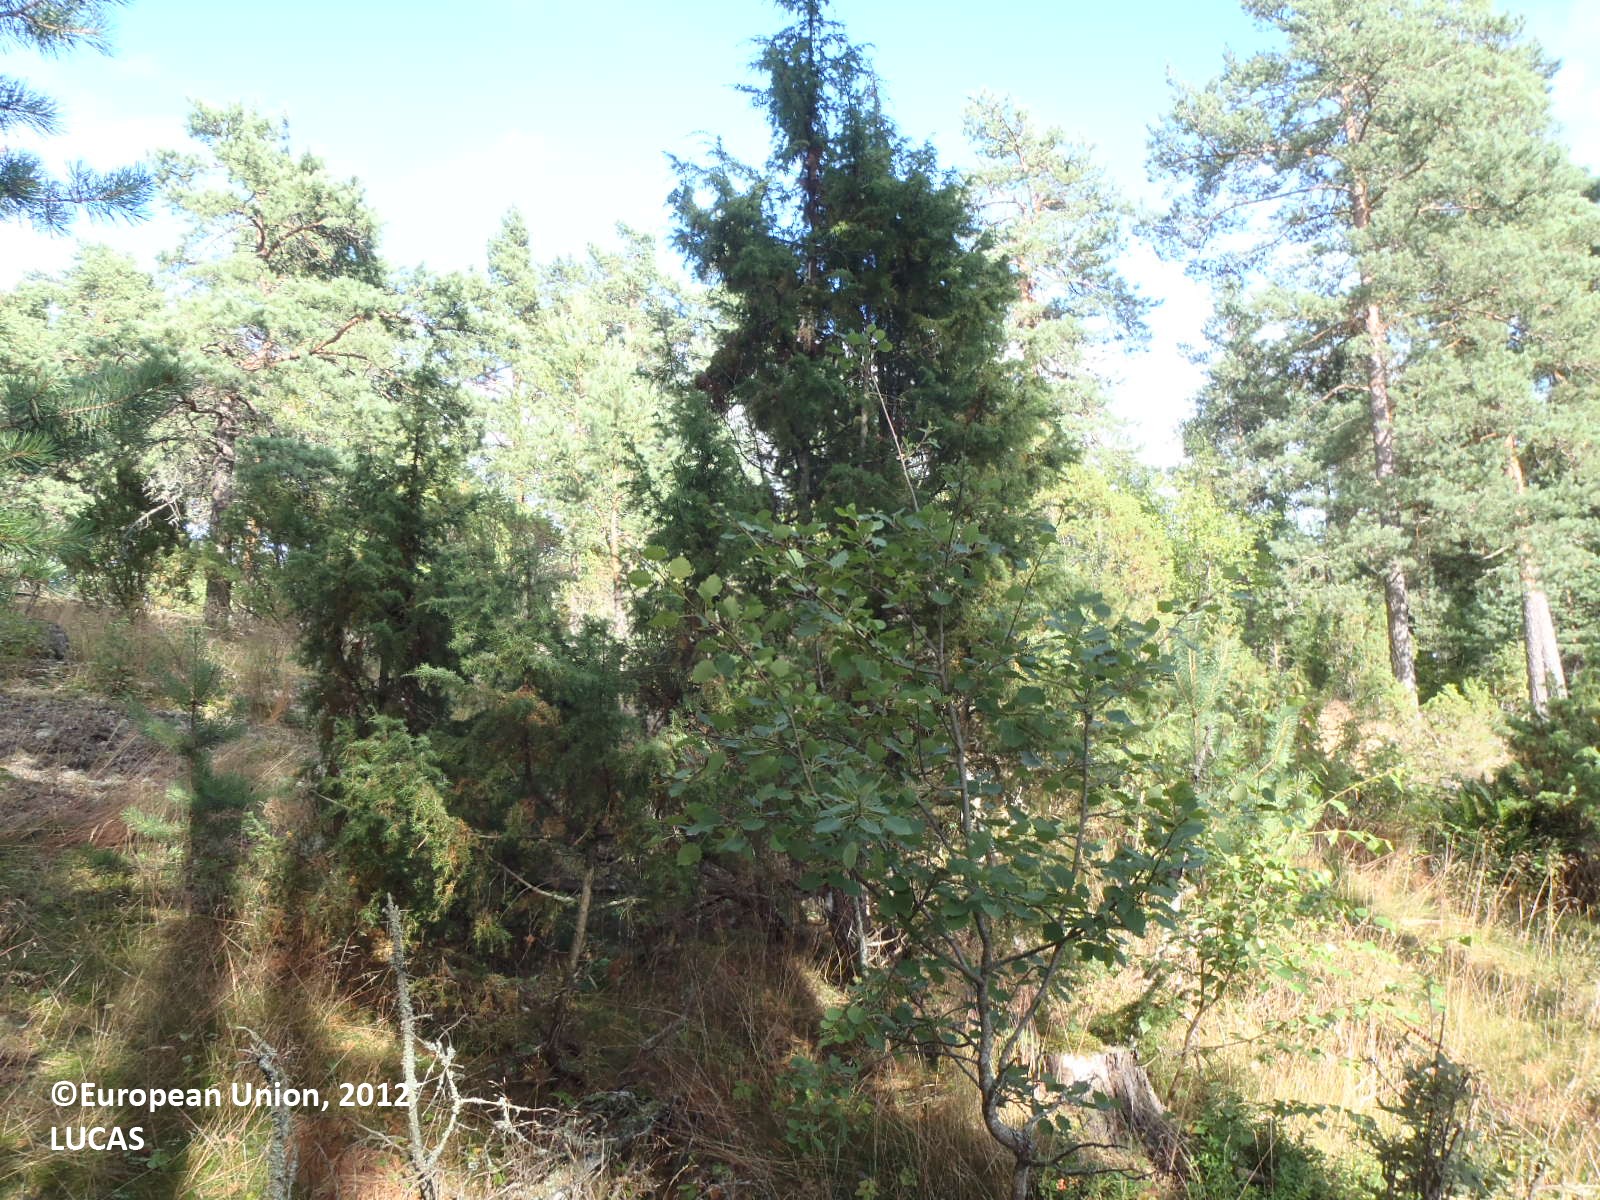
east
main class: Woodland
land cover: Pine dominated coniferous woodland
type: boreal forest
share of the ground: > 75 %
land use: Forestry
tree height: > 5 m
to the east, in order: Pine dominated coniferous woodland; Spruce dominated mixed woodland; Pine dominated mixed woodland; Spruce dominated mixed woodland; Tracks; Spruce dominated mixed woodland
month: August
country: FI
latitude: 60.3308
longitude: 22.3301
